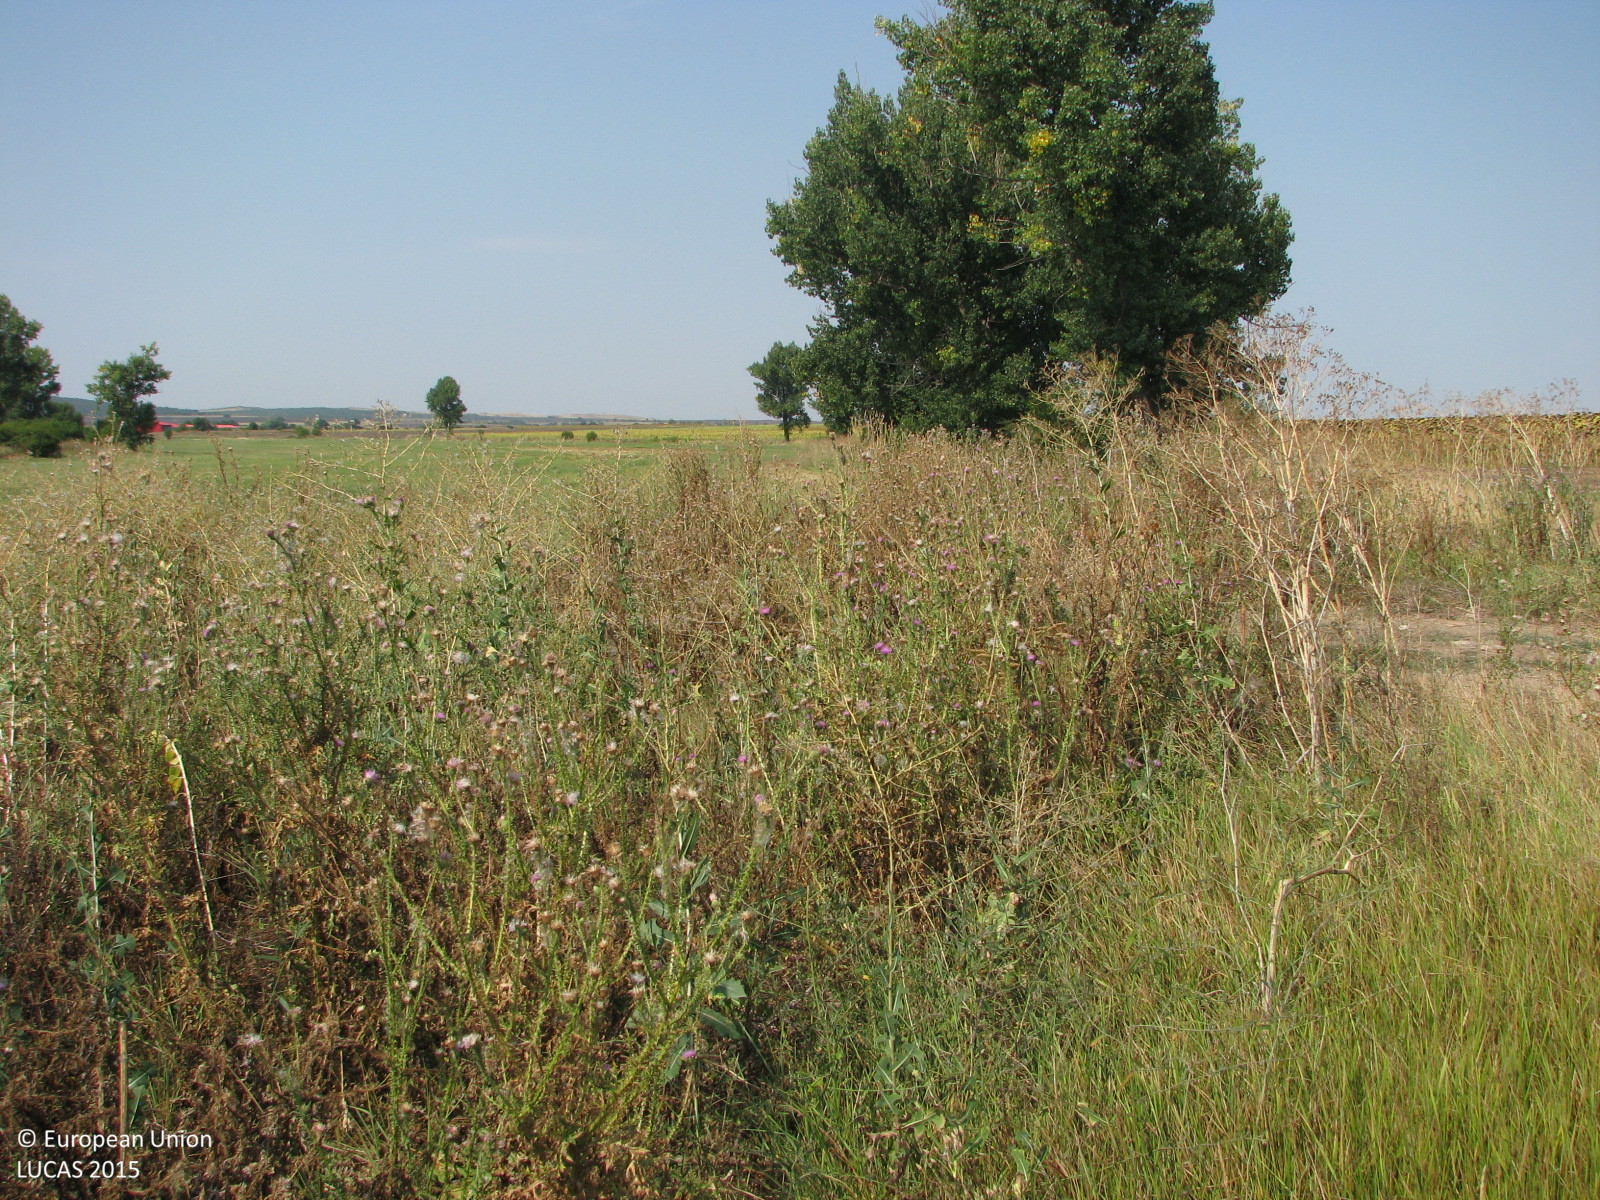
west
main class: Grassland
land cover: Grassland with sparse tree/shrub cover
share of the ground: > 75 %
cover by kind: herbaceous plants 95 %, broadleaved forest trees 5 %
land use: Semi-natural and natural areas not in use
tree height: > 5 m
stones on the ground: < 10 %
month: August
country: BG
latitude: 42.4067
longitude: 26.3075
